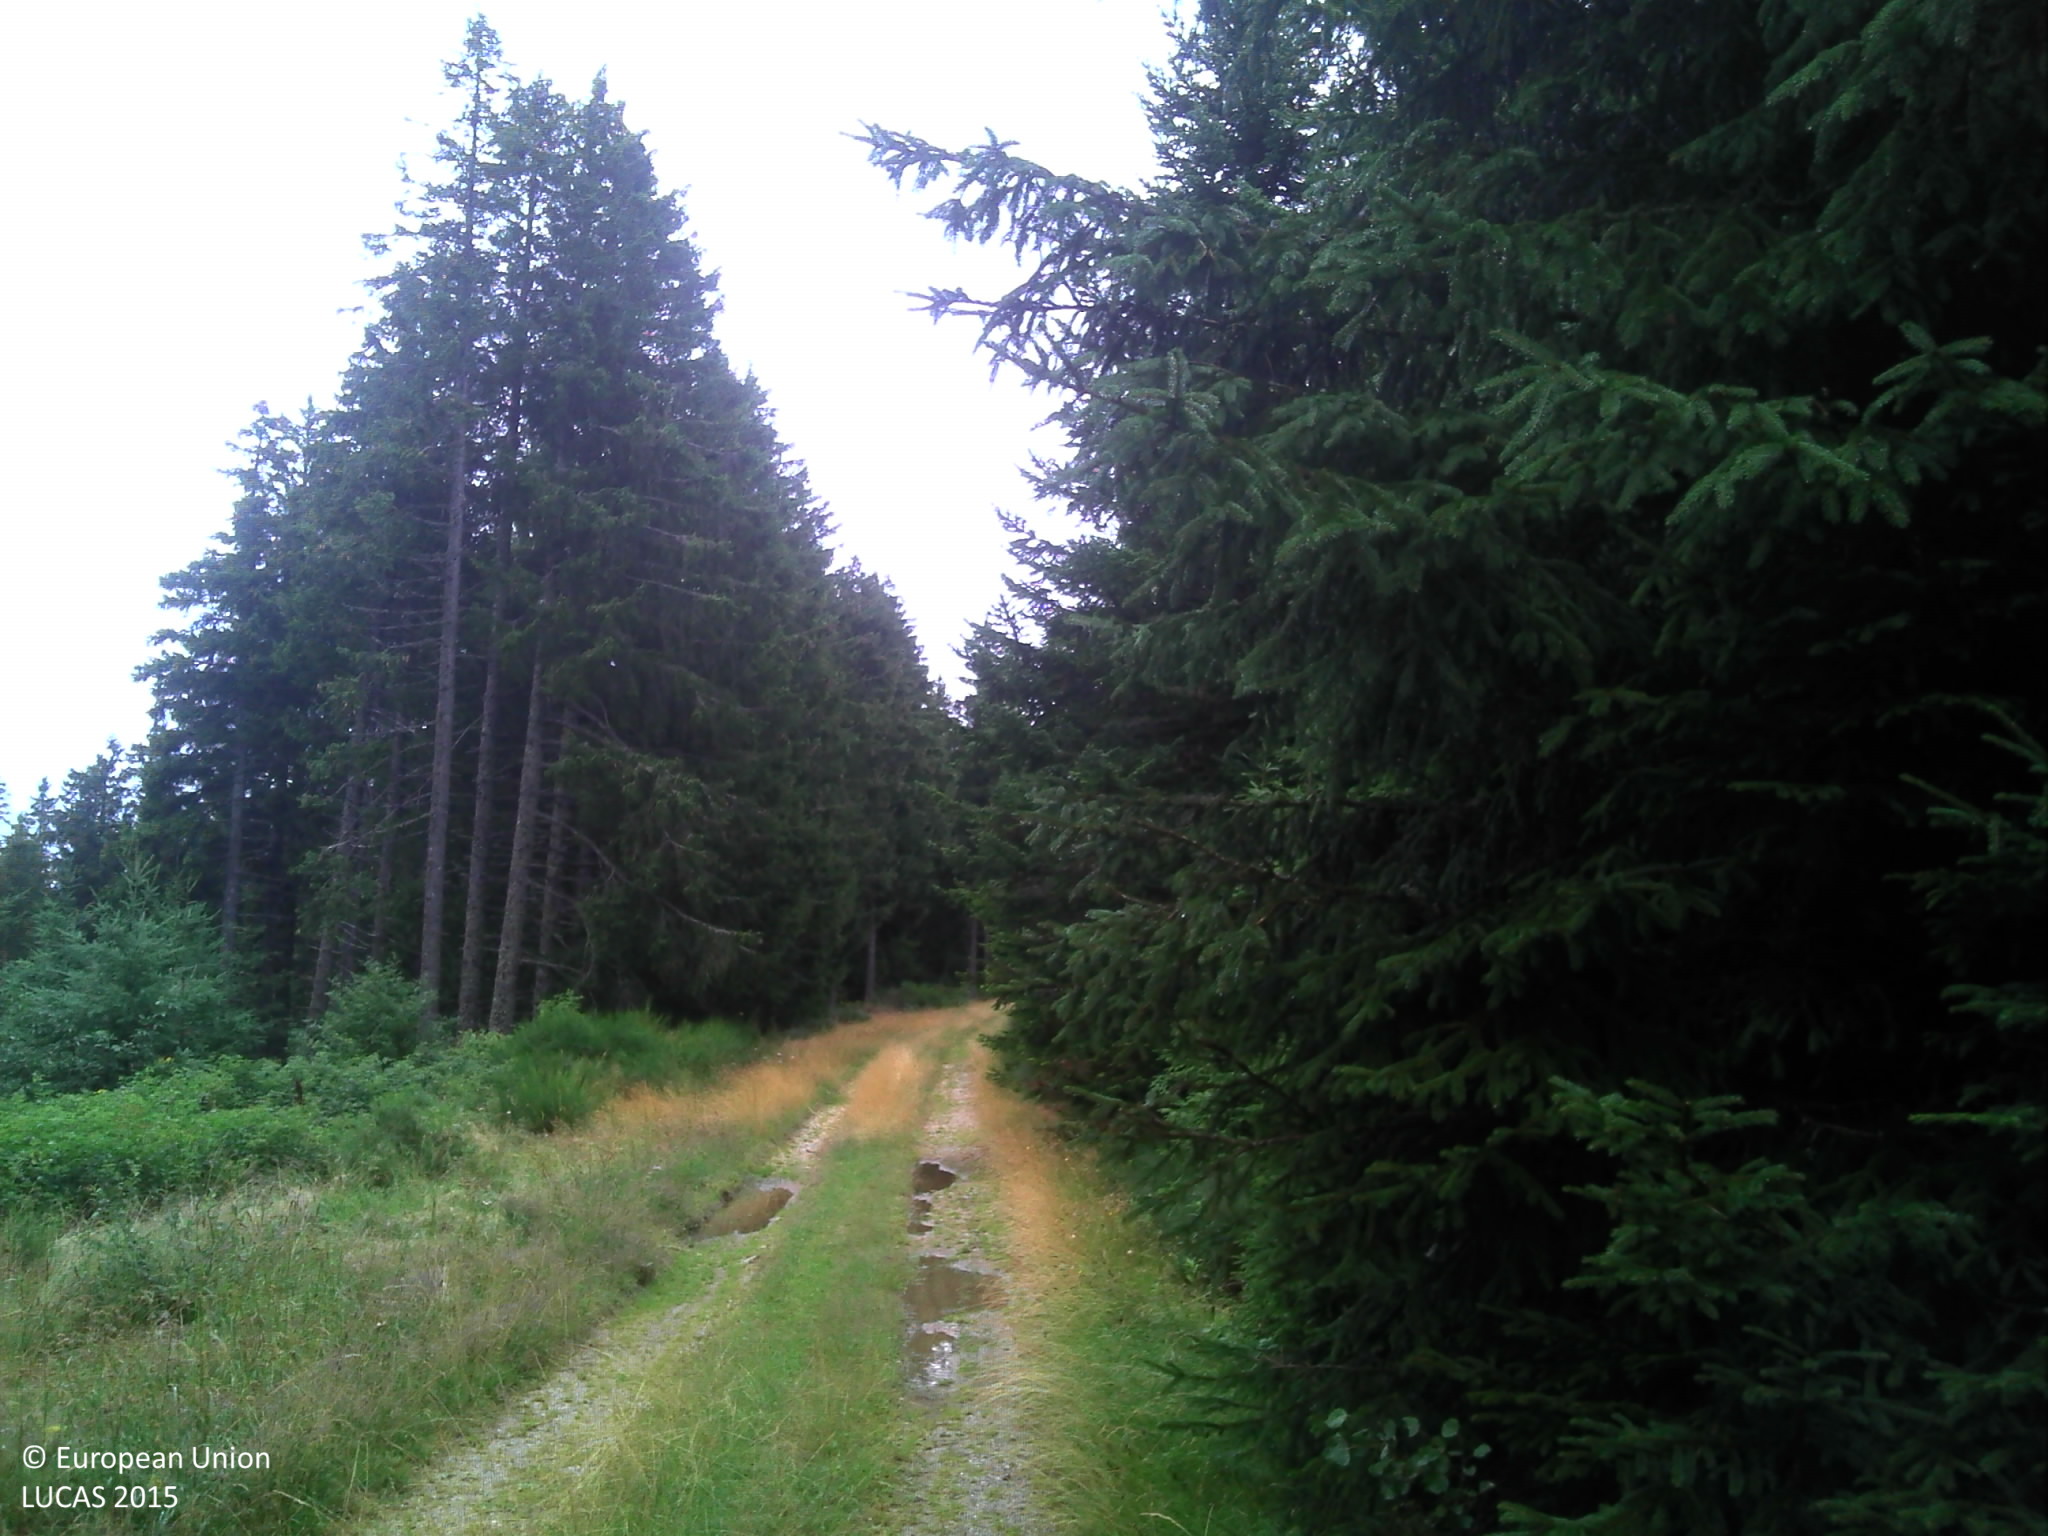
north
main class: Woodland
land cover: Spruce dominated coniferous woodland
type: alpine coniferous forest
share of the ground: > 75 %
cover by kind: coniferous forest trees 95 %, broadleaved forest trees 5 %
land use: Forestry
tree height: > 5 m
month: July
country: FR
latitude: 44.7451
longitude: 3.5252
